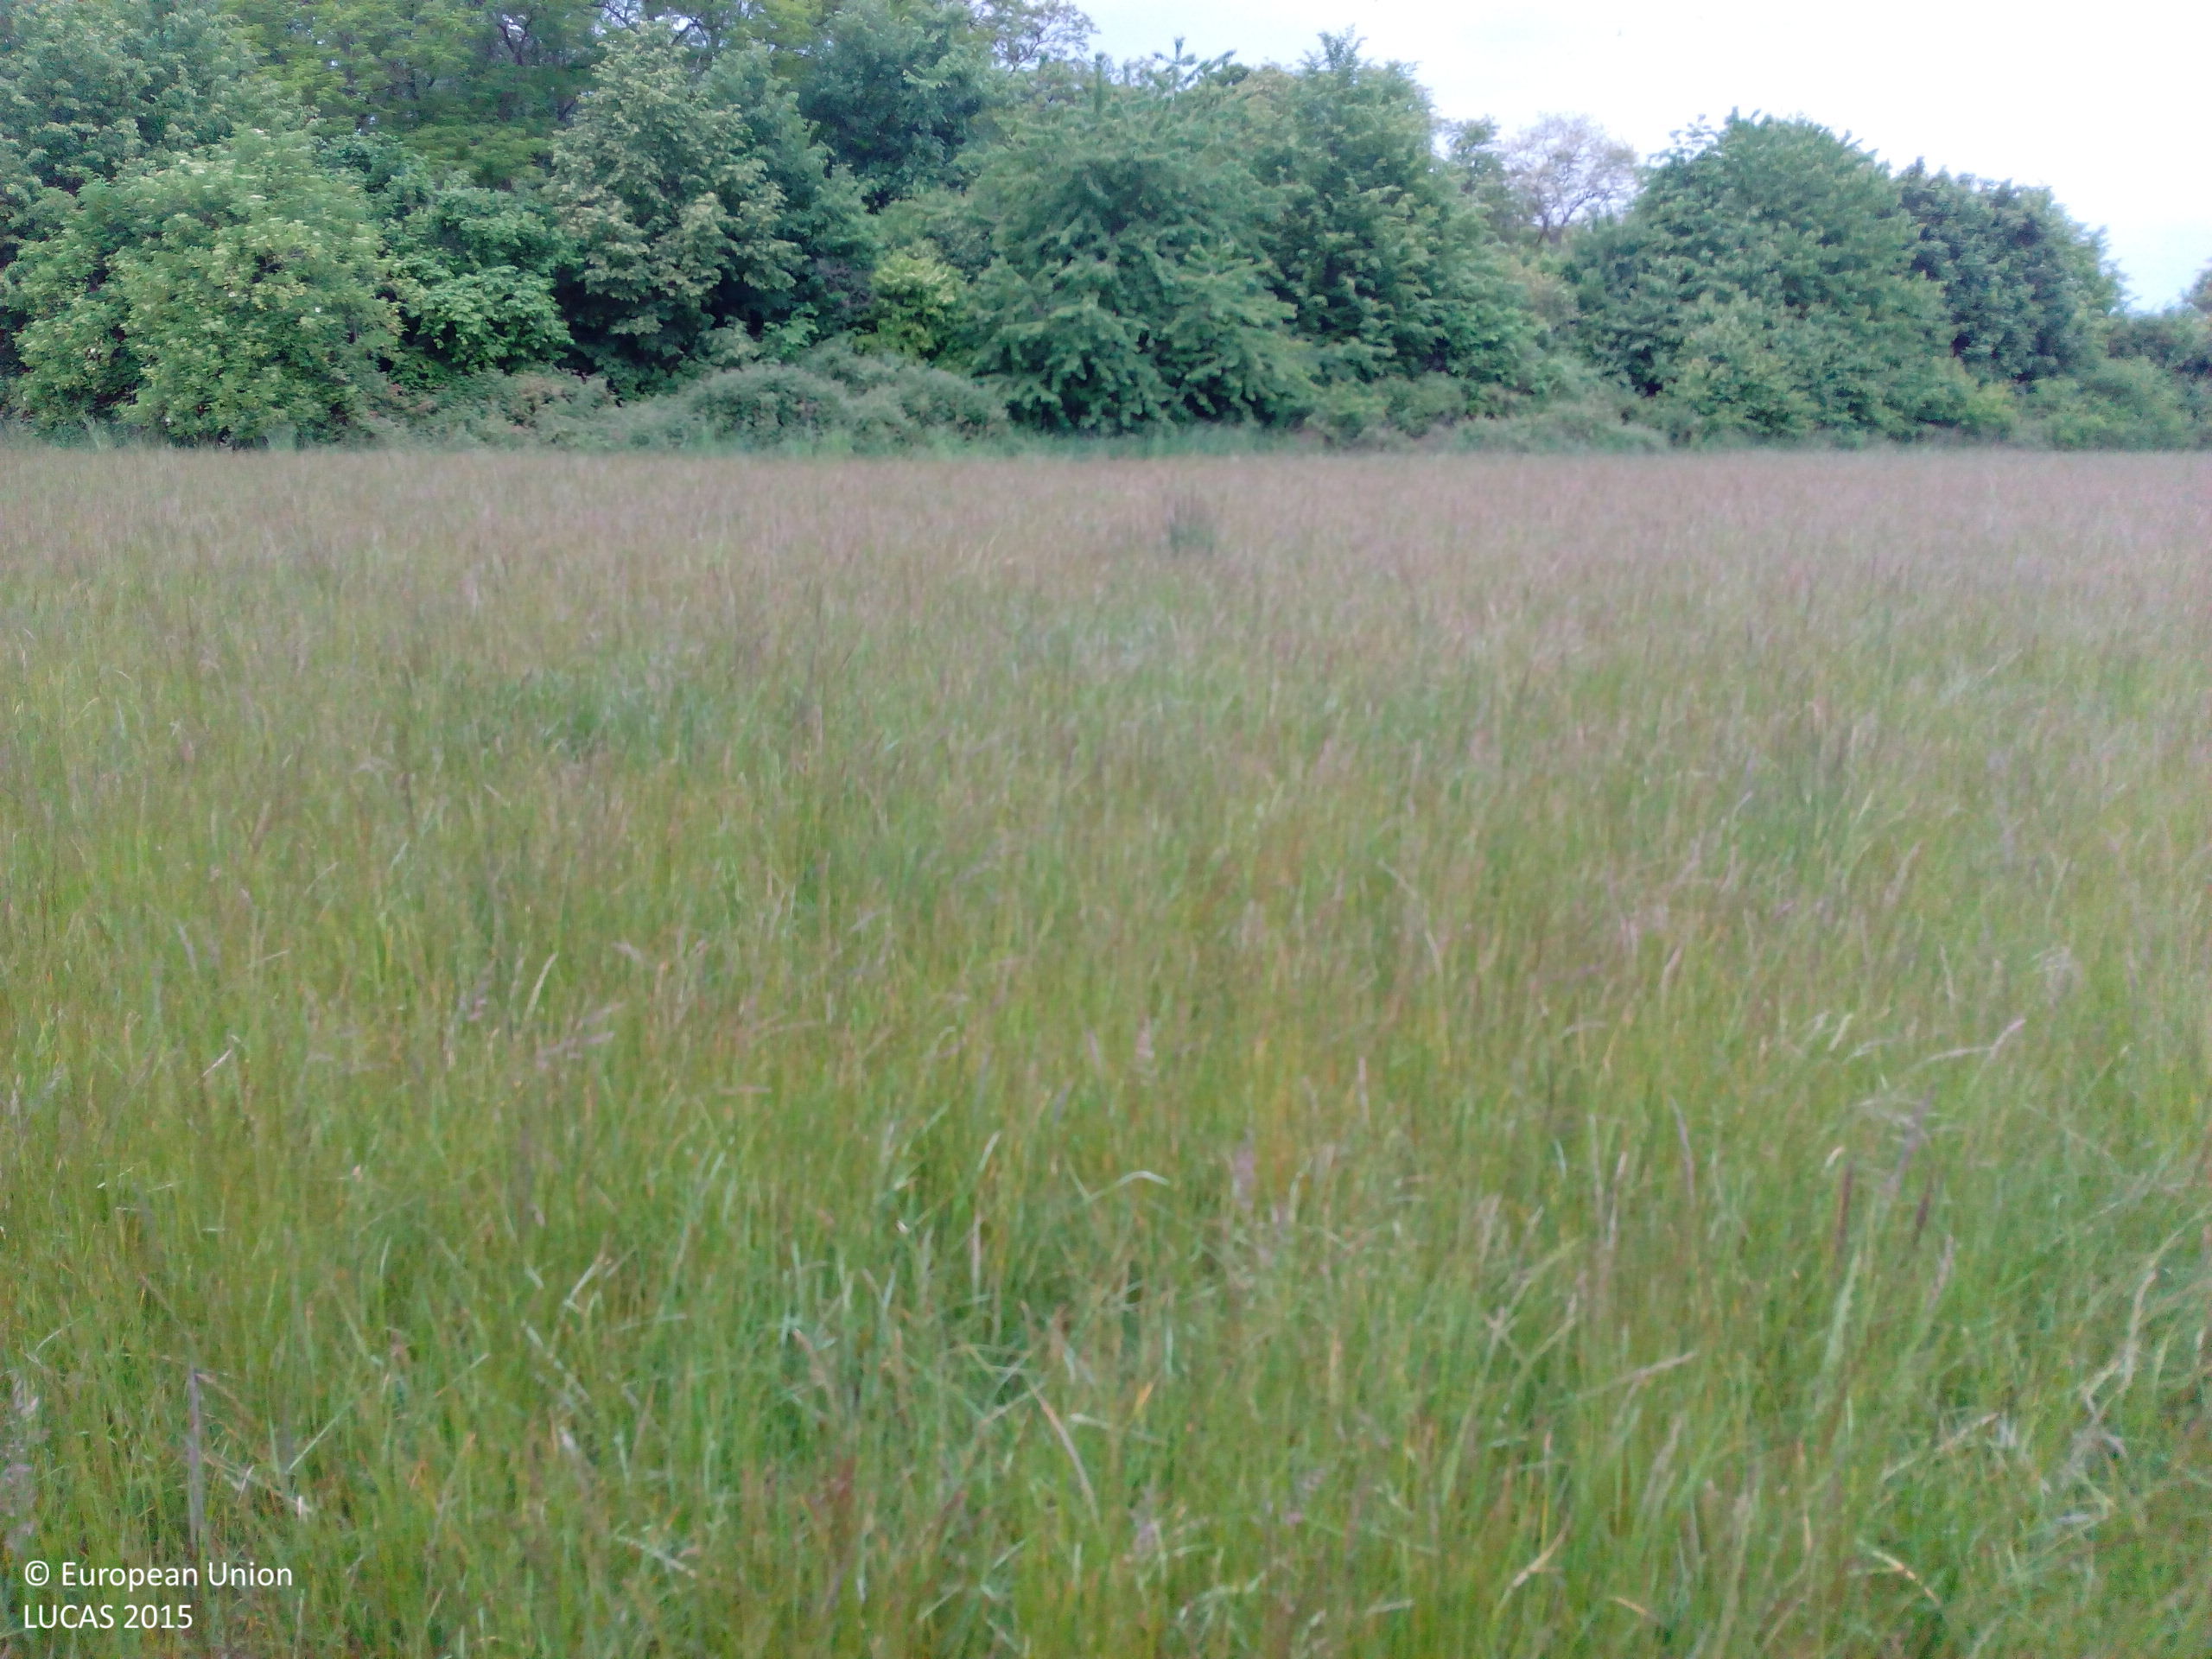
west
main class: Cropland
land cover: Barley
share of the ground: > 75 %
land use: Agriculture (excluding fallow land and kitchen gardens)
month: May
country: DE
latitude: 51.7275
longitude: 12.2148
